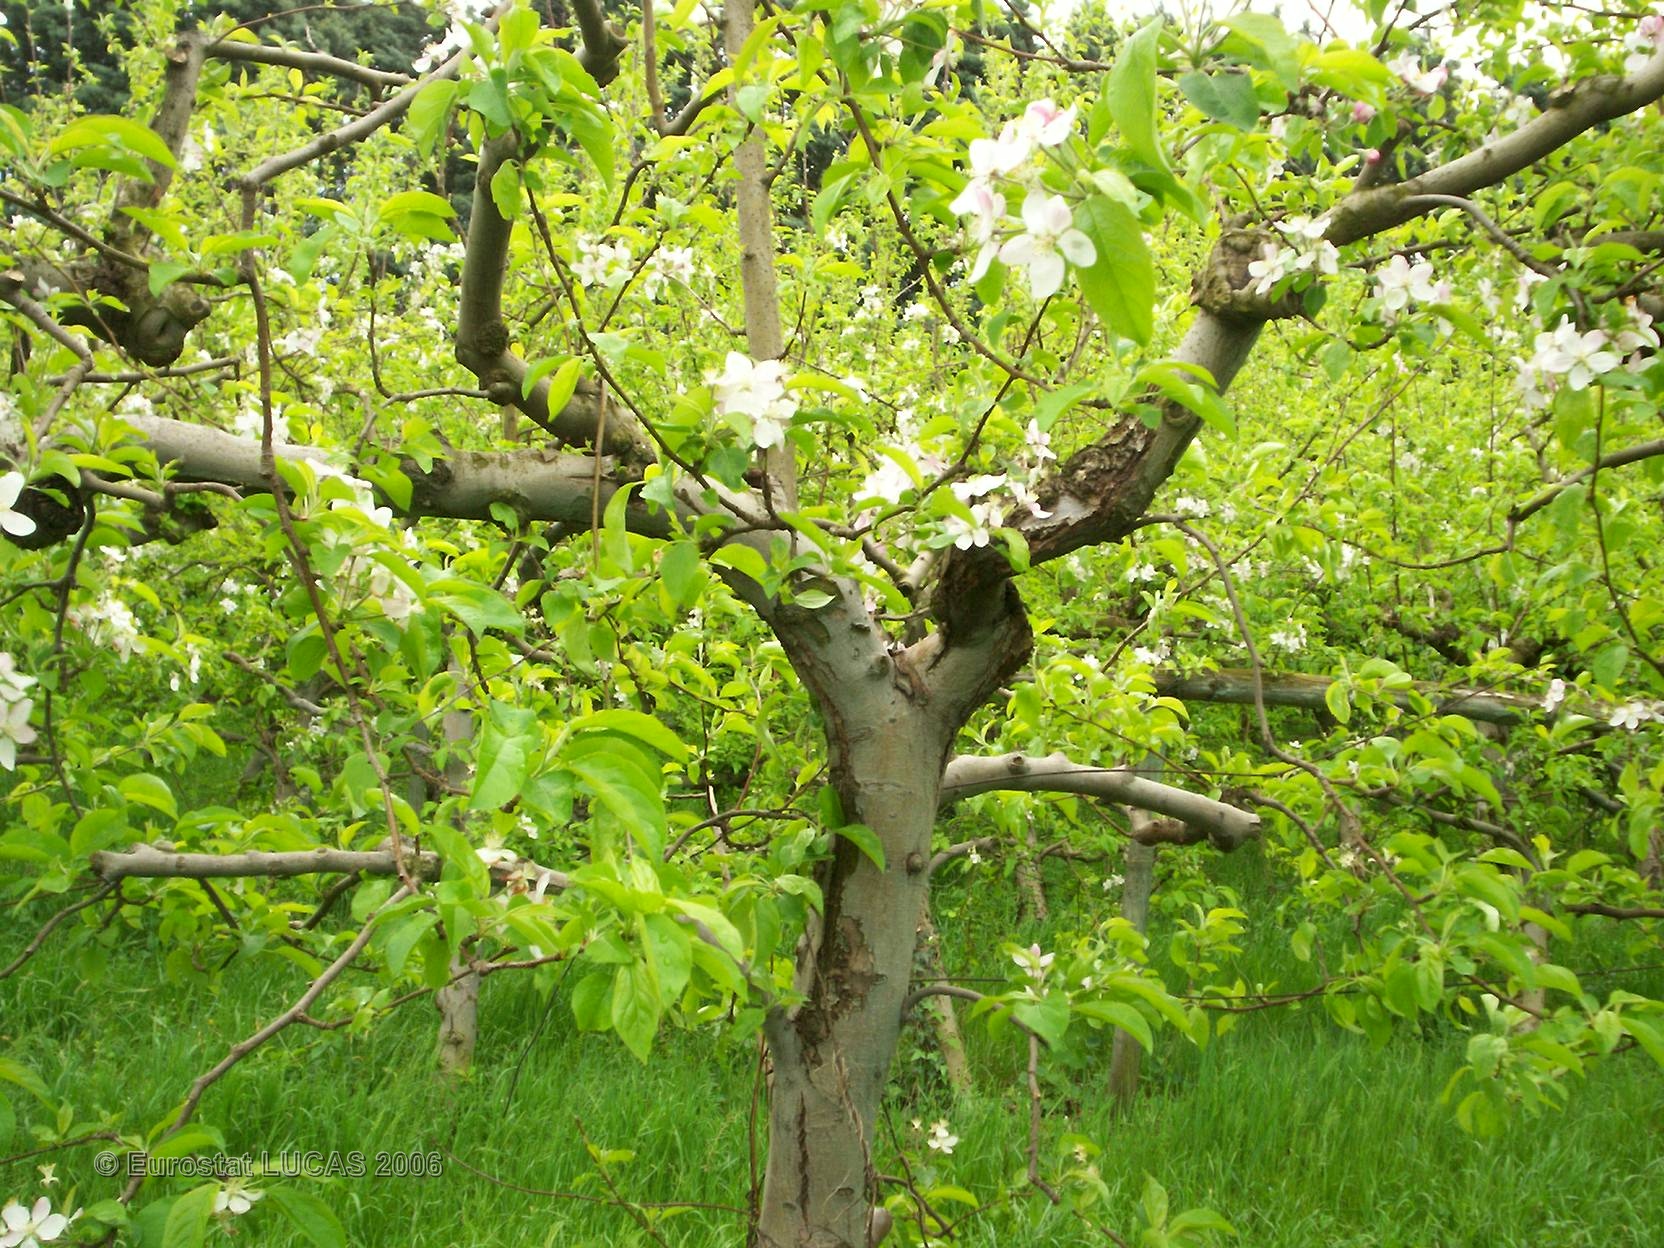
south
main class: Cropland
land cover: Apple fruit
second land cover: Grassland with sparse tree/shrub cover
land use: Agriculture (excluding fallow land and kitchen gardens)
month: April
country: FR
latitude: 43.8095
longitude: 4.8998
